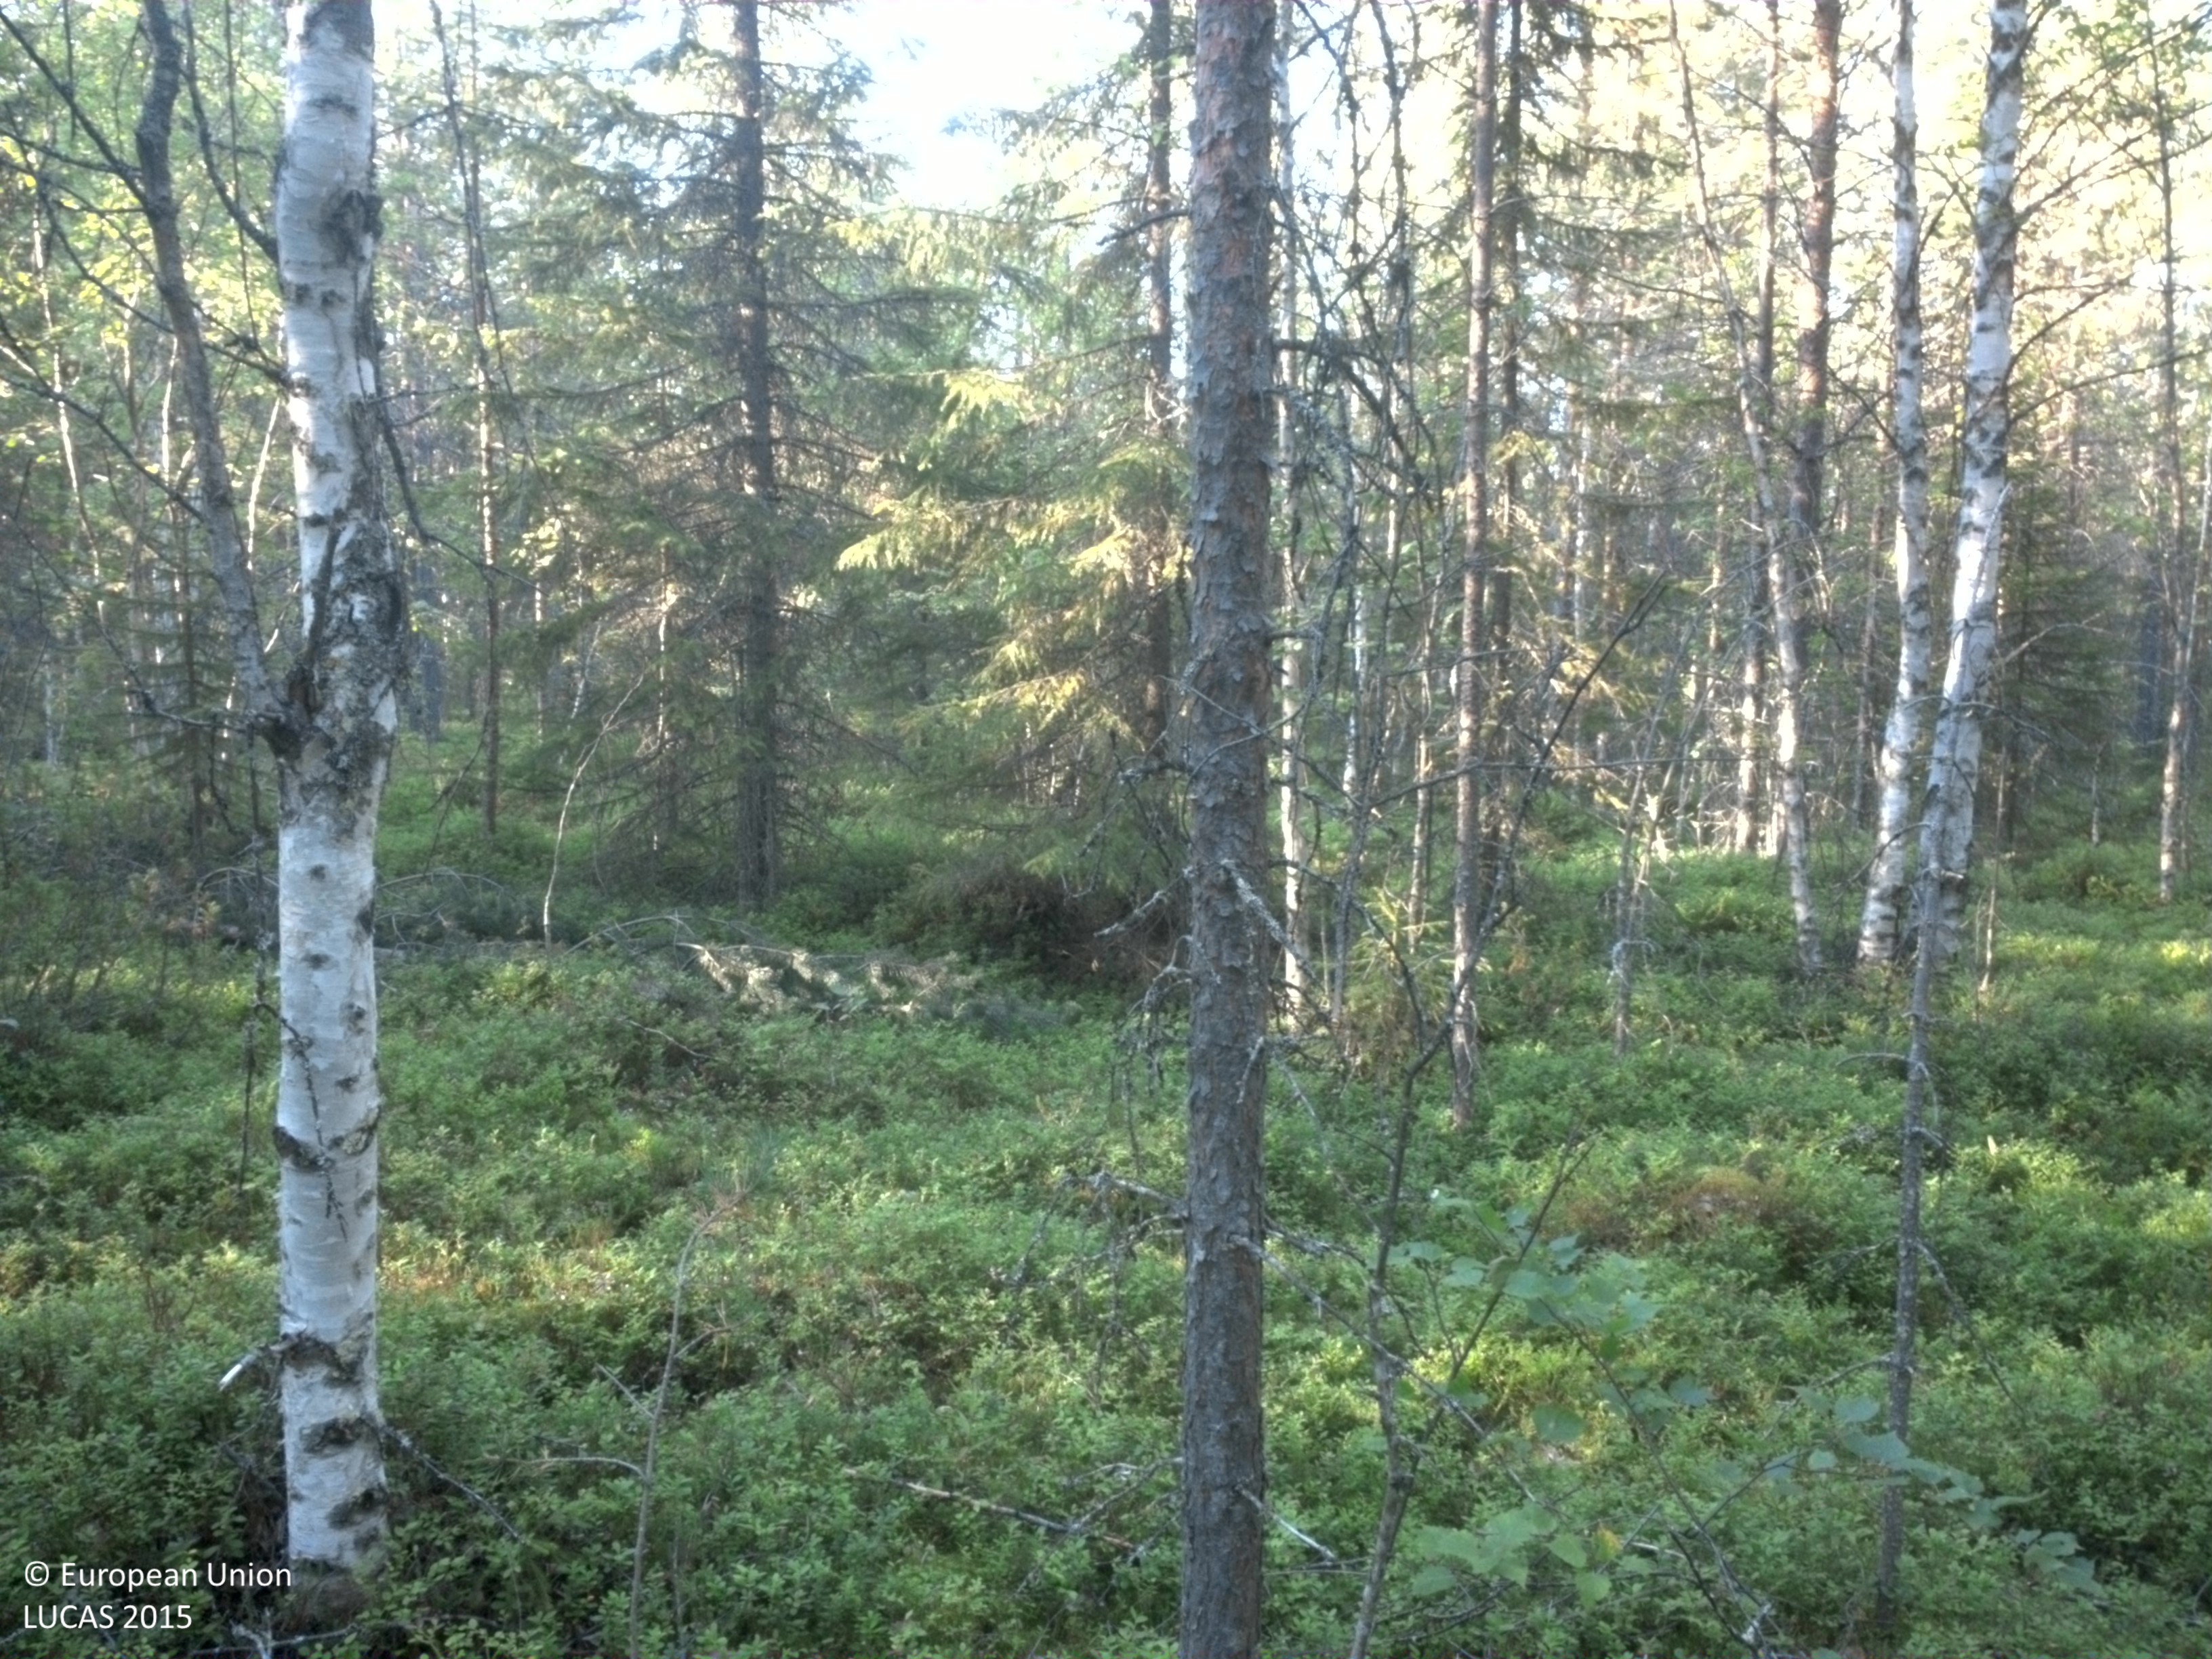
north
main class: Woodland
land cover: Pine dominated mixed woodland
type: boreal forest
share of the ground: 50 - 75 %
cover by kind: coniferous forest trees 45 %, shrubs 35 %, broadleaved forest trees 15 %, lichens and mosses 5 %
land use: Forestry
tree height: > 5 m
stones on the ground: 25 - 50 %
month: August
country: SE
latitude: 64.6500
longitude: 19.0327
